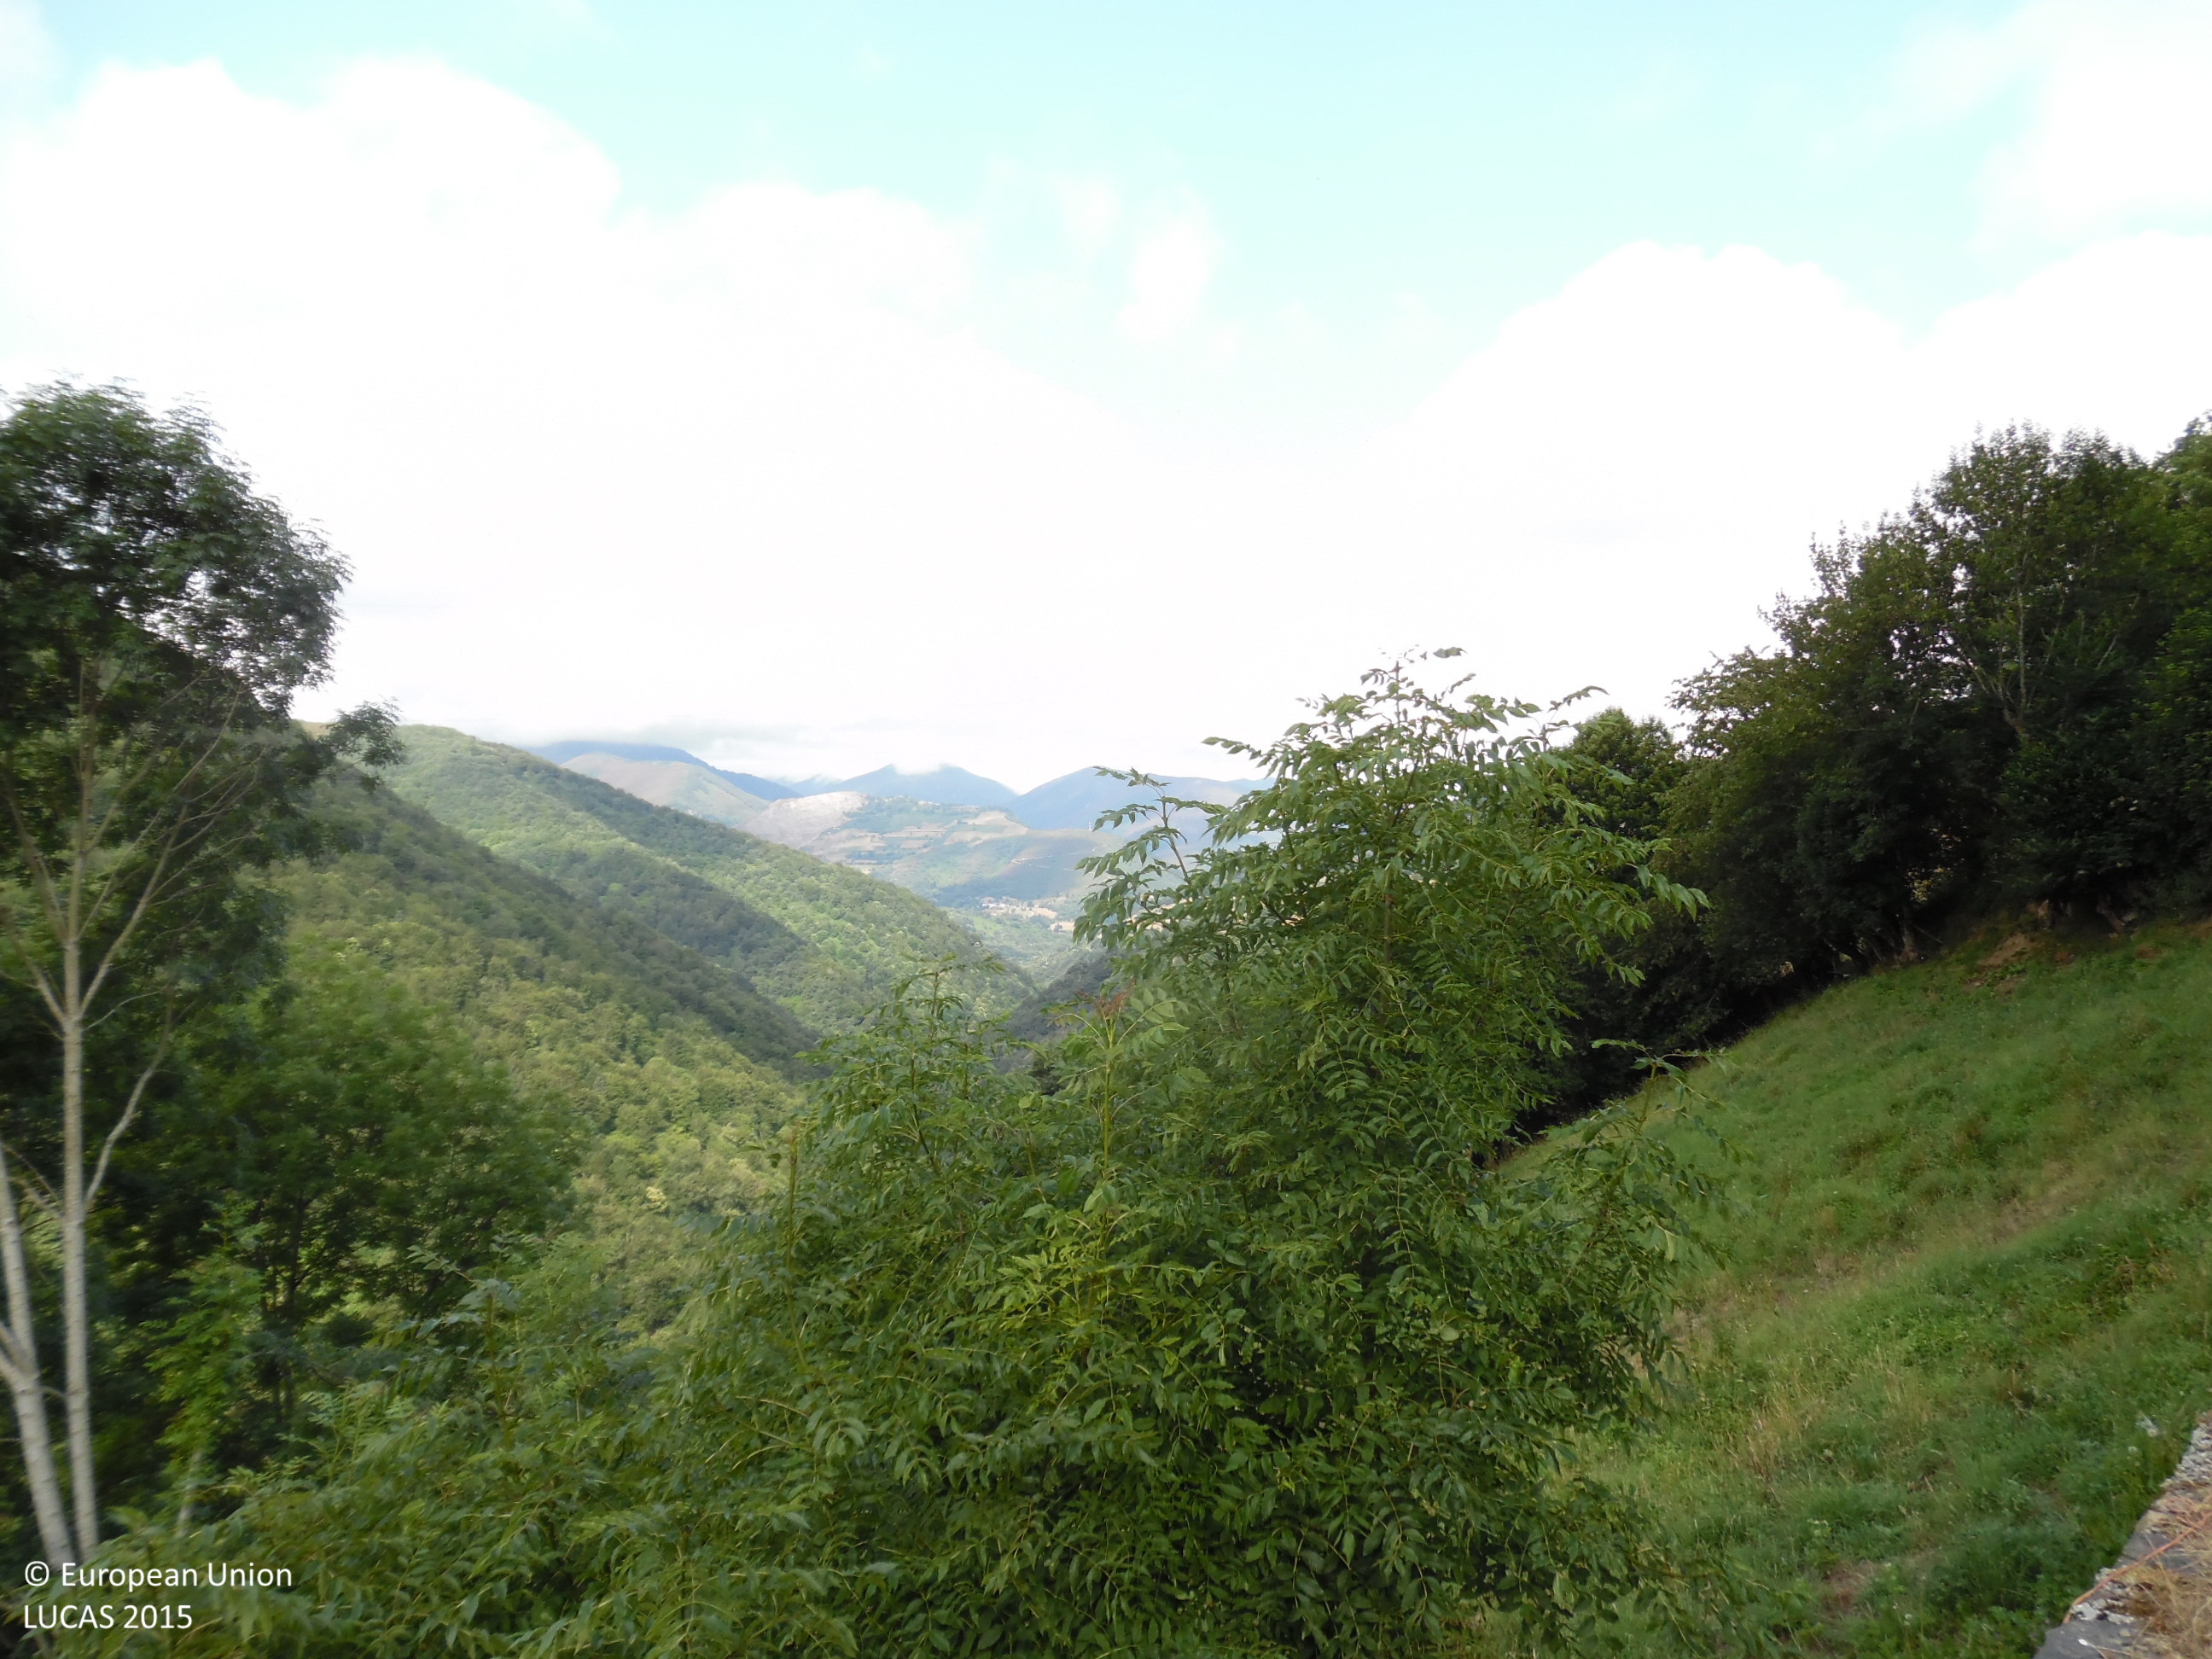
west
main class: Grassland
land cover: Grassland with sparse tree/shrub cover
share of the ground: > 75 %
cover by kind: herbaceous plants 90 %, broadleaved forest trees 5 %
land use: Agriculture (excluding fallow land and kitchen gardens)
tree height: > 5 m
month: July
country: ES
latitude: 43.0451
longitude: -6.5624
